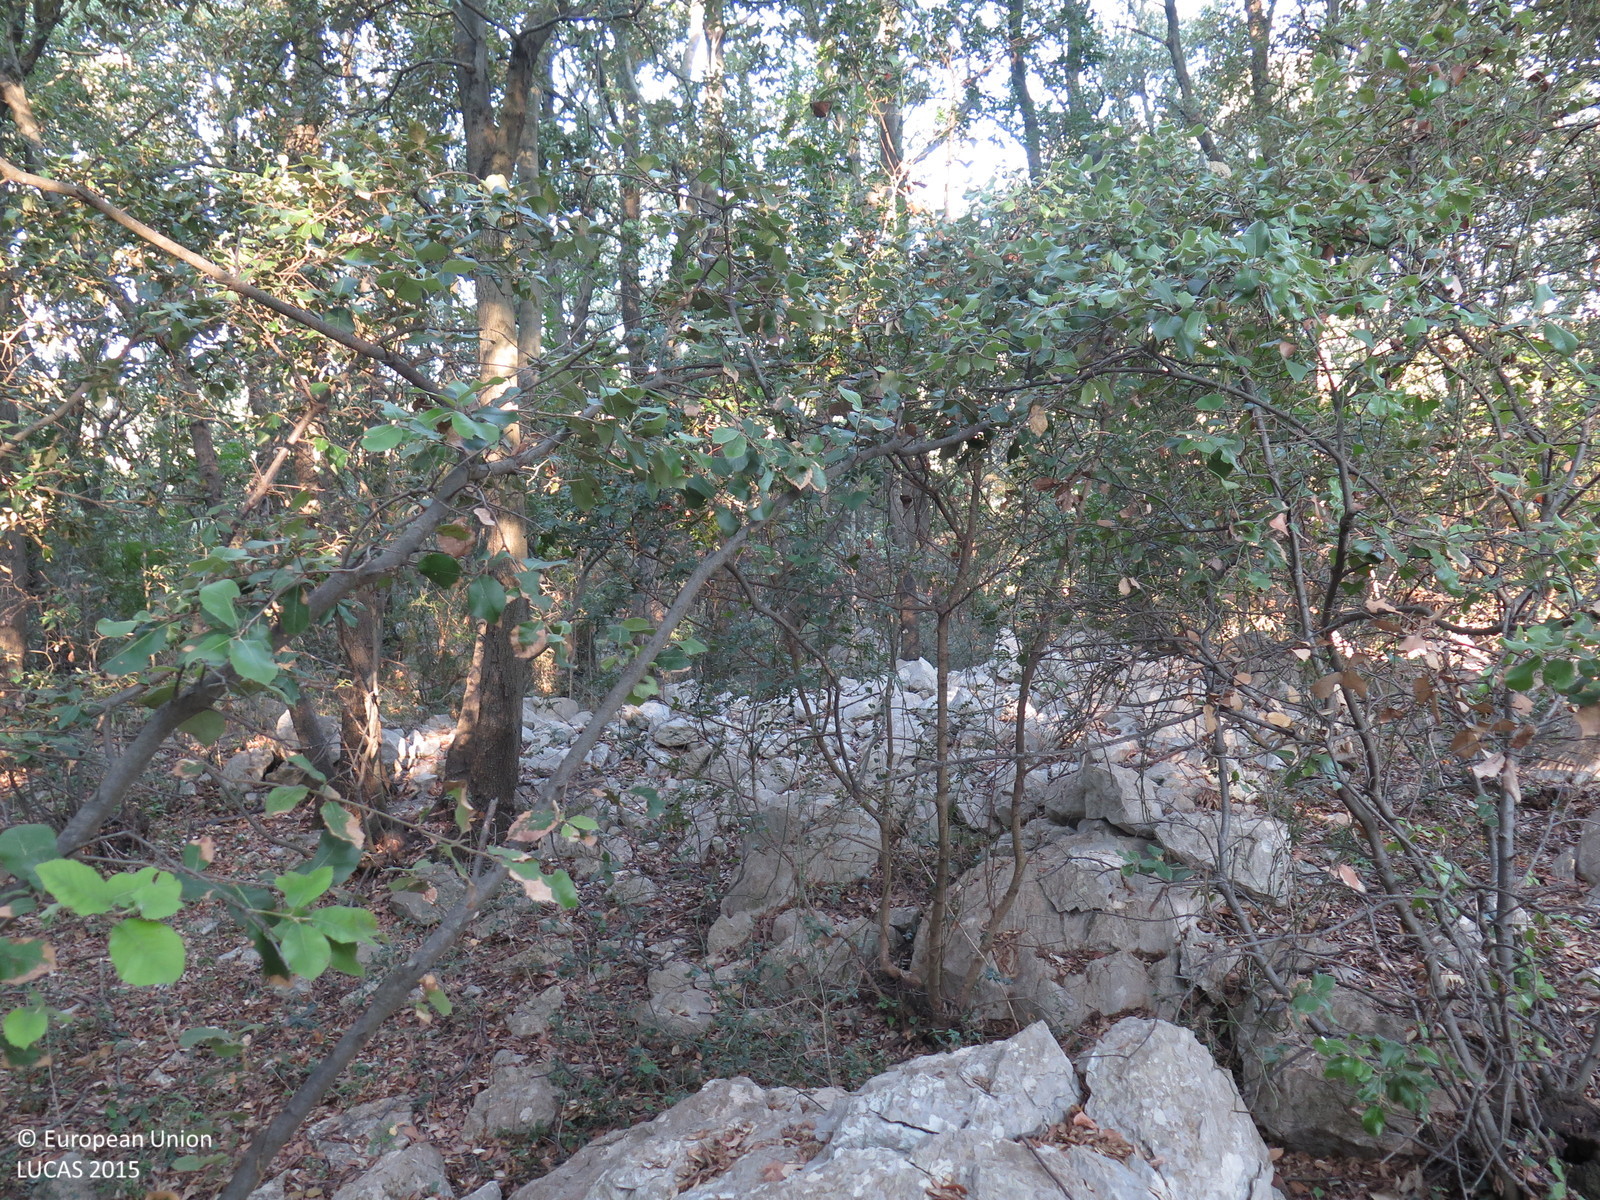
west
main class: Woodland
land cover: Broadleaved woodland
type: thermophilous deciduous forest
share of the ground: > 75 %
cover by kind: broadleaved forest trees 90 %, shrubs 5 %, unconsolidated bare surface 5 %
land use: Forestry
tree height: > 5 m
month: August
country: HR
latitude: 44.7676
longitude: 14.7065
